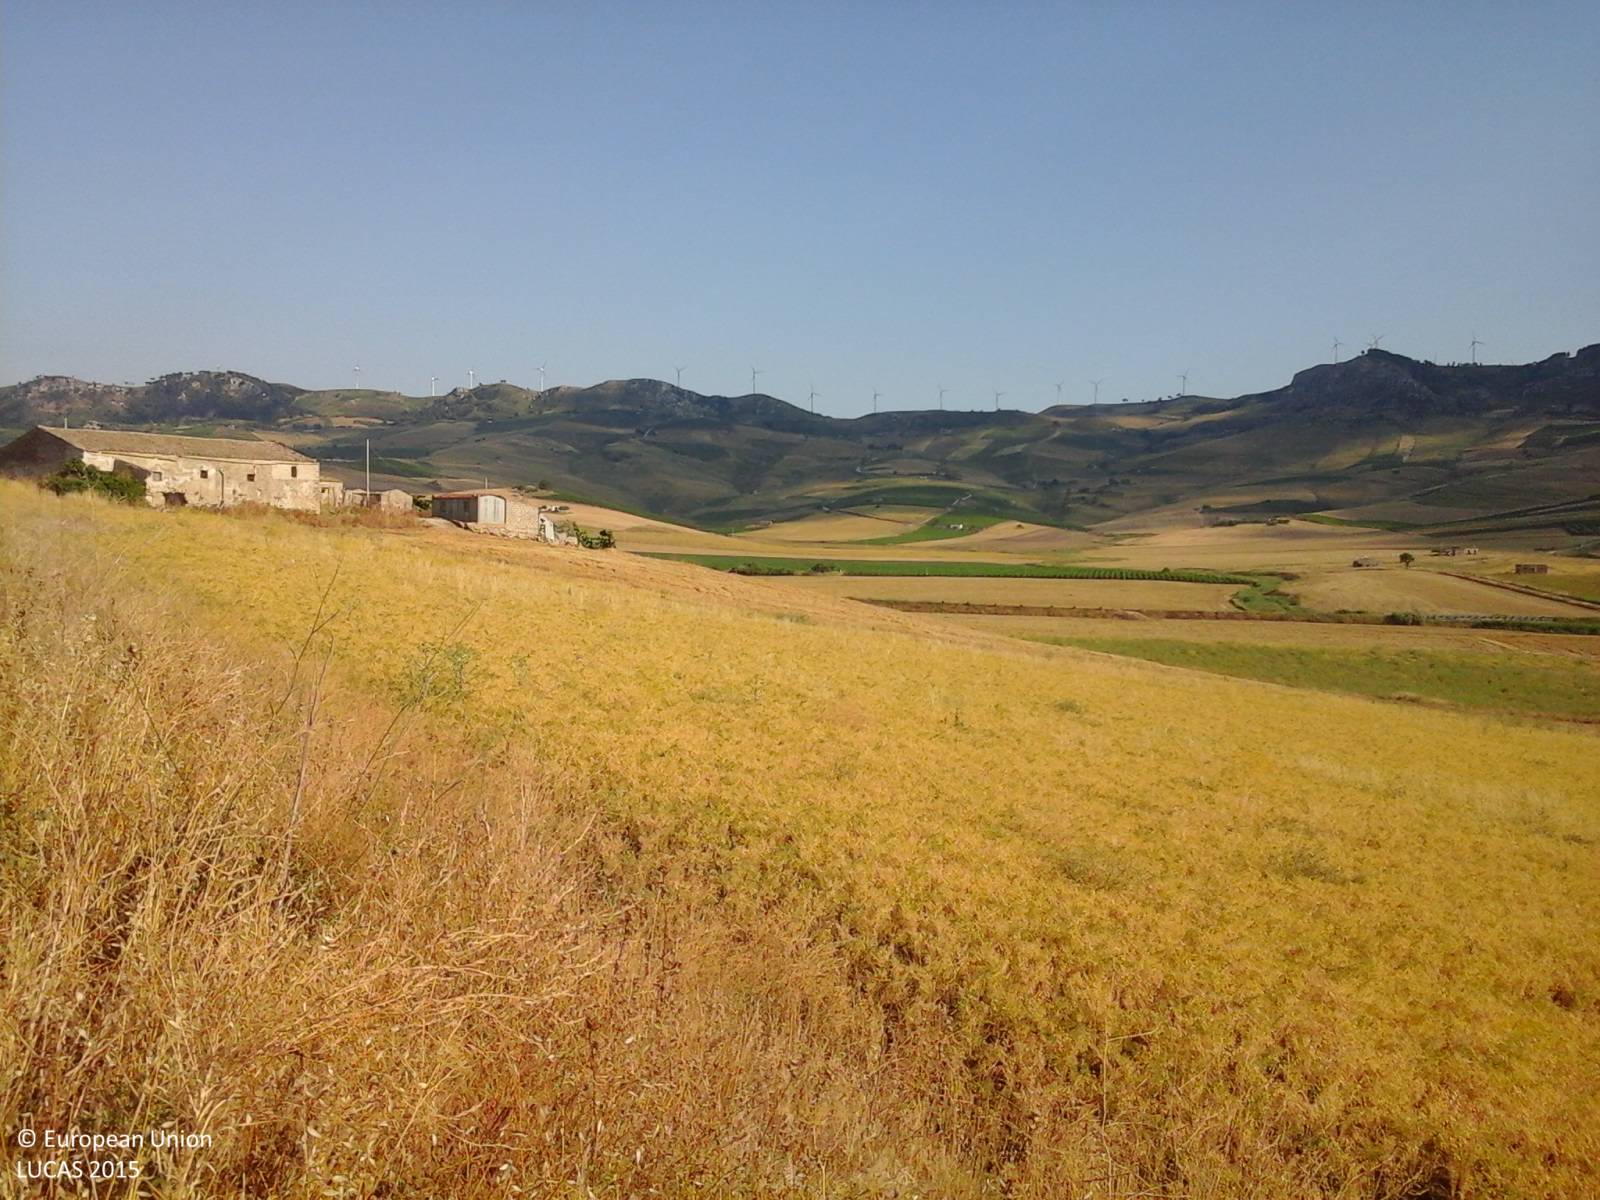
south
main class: Cropland
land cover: Dry pulses
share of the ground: > 75 %
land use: Agriculture (excluding fallow land and kitchen gardens)
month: July
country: IT
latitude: 37.8291
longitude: 12.9437
